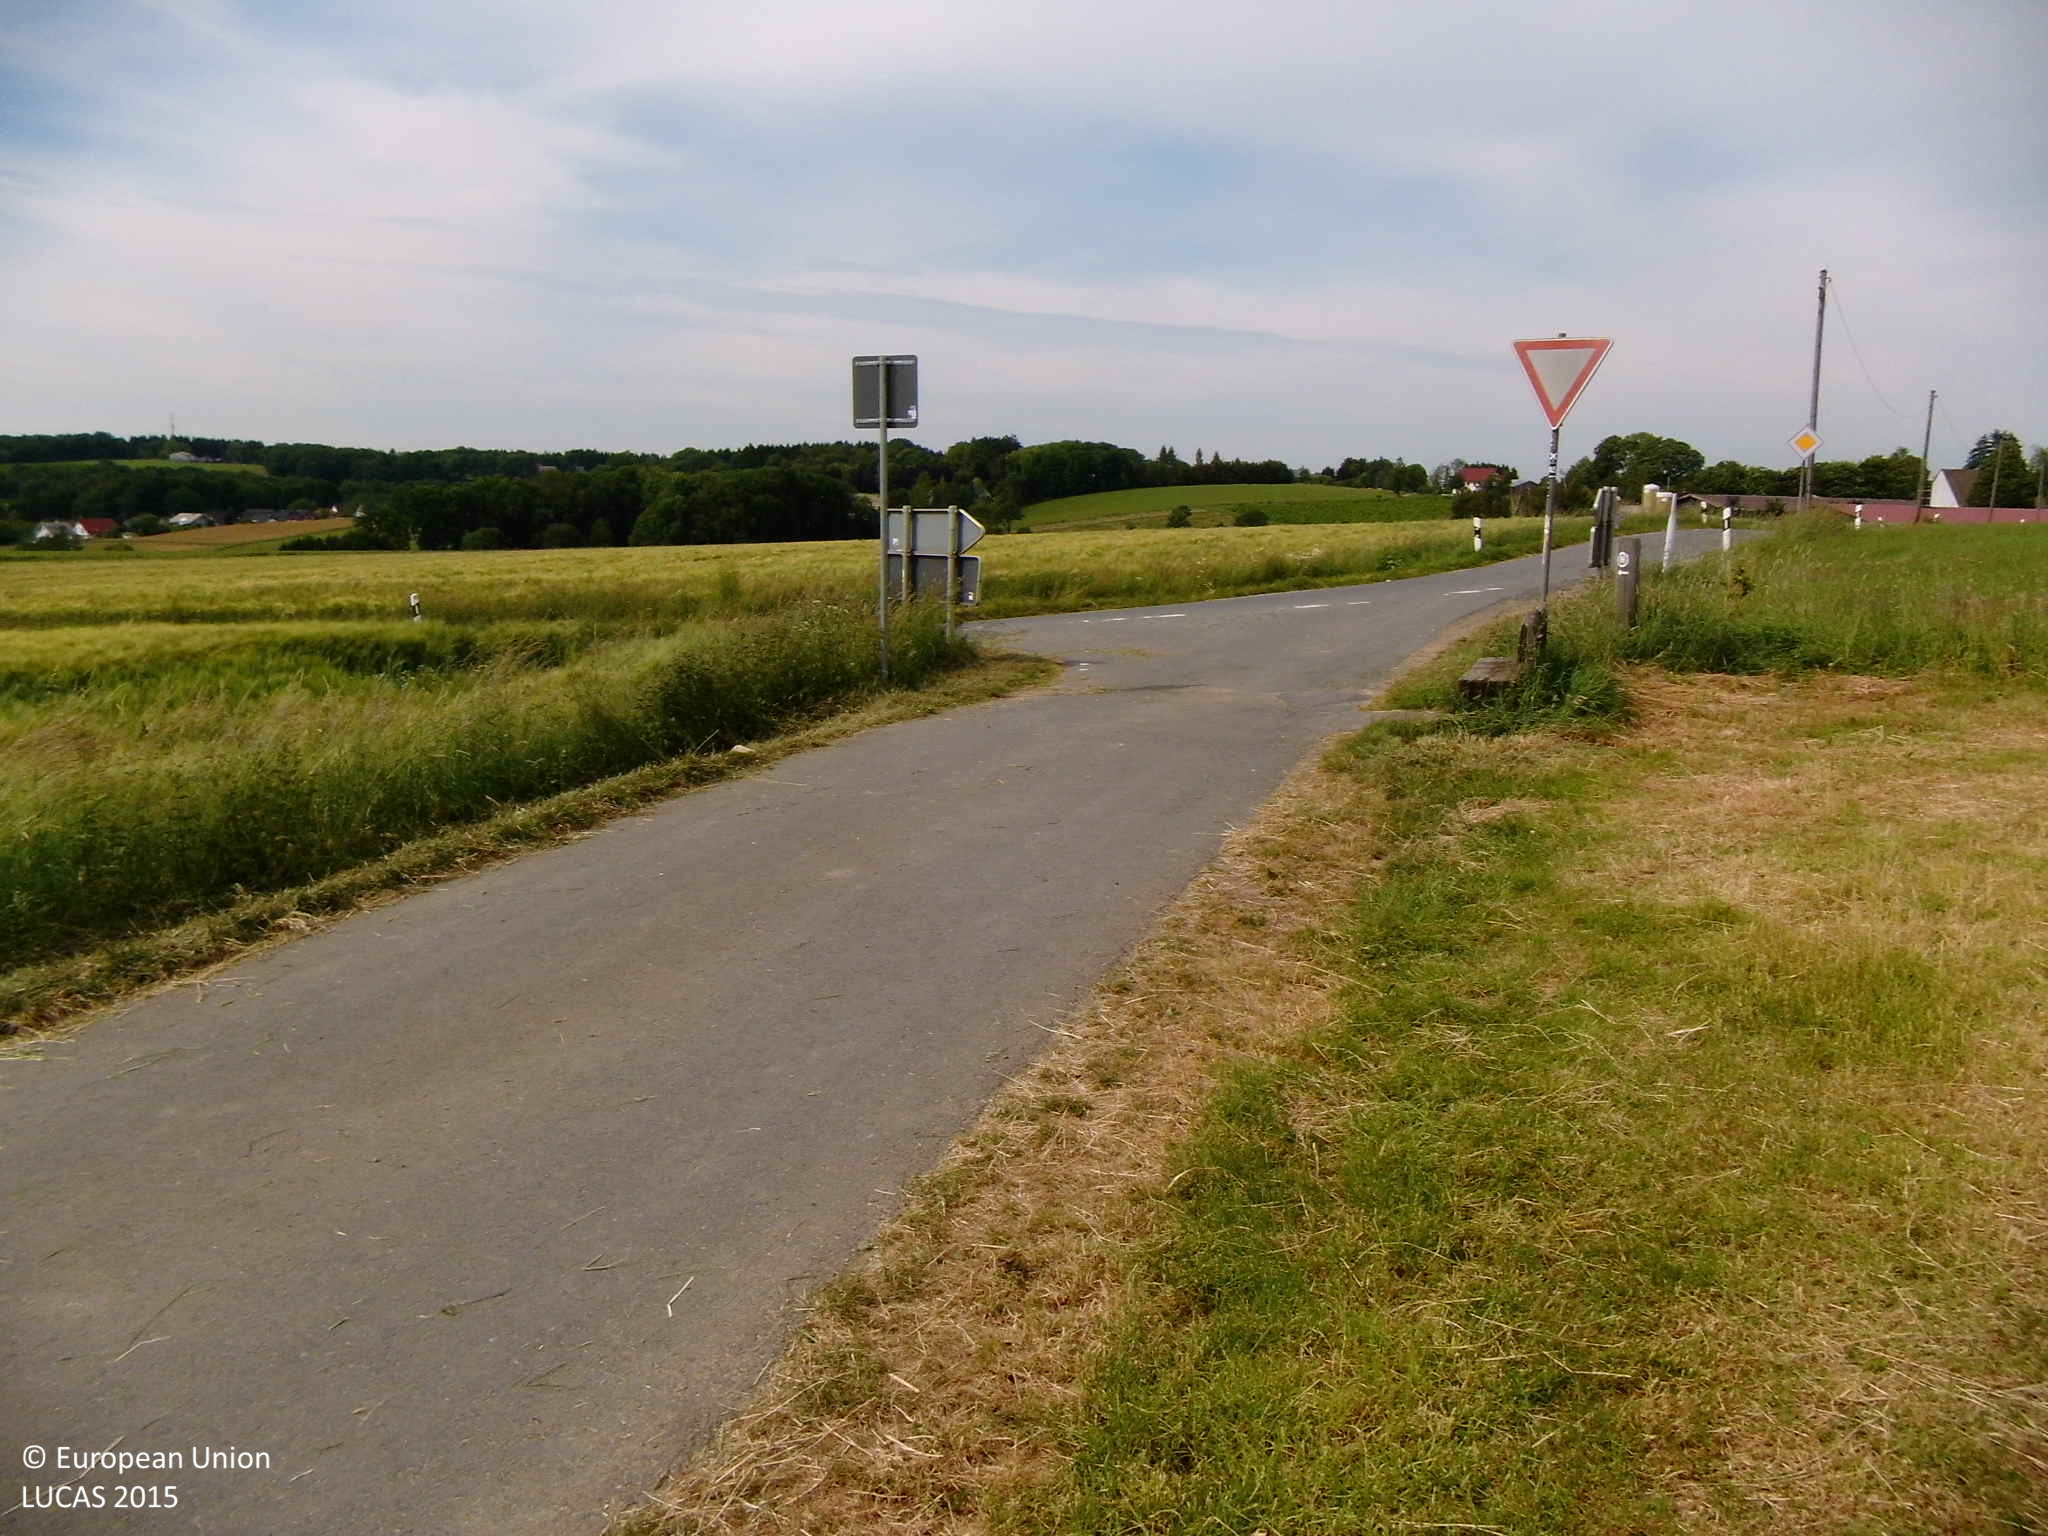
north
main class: Grassland
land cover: Grassland without tree/shrub cover
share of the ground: > 75 %
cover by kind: herbaceous plants 100 %
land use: Agriculture (excluding fallow land and kitchen gardens)
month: June
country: DE
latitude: 51.1809
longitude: 7.4395
